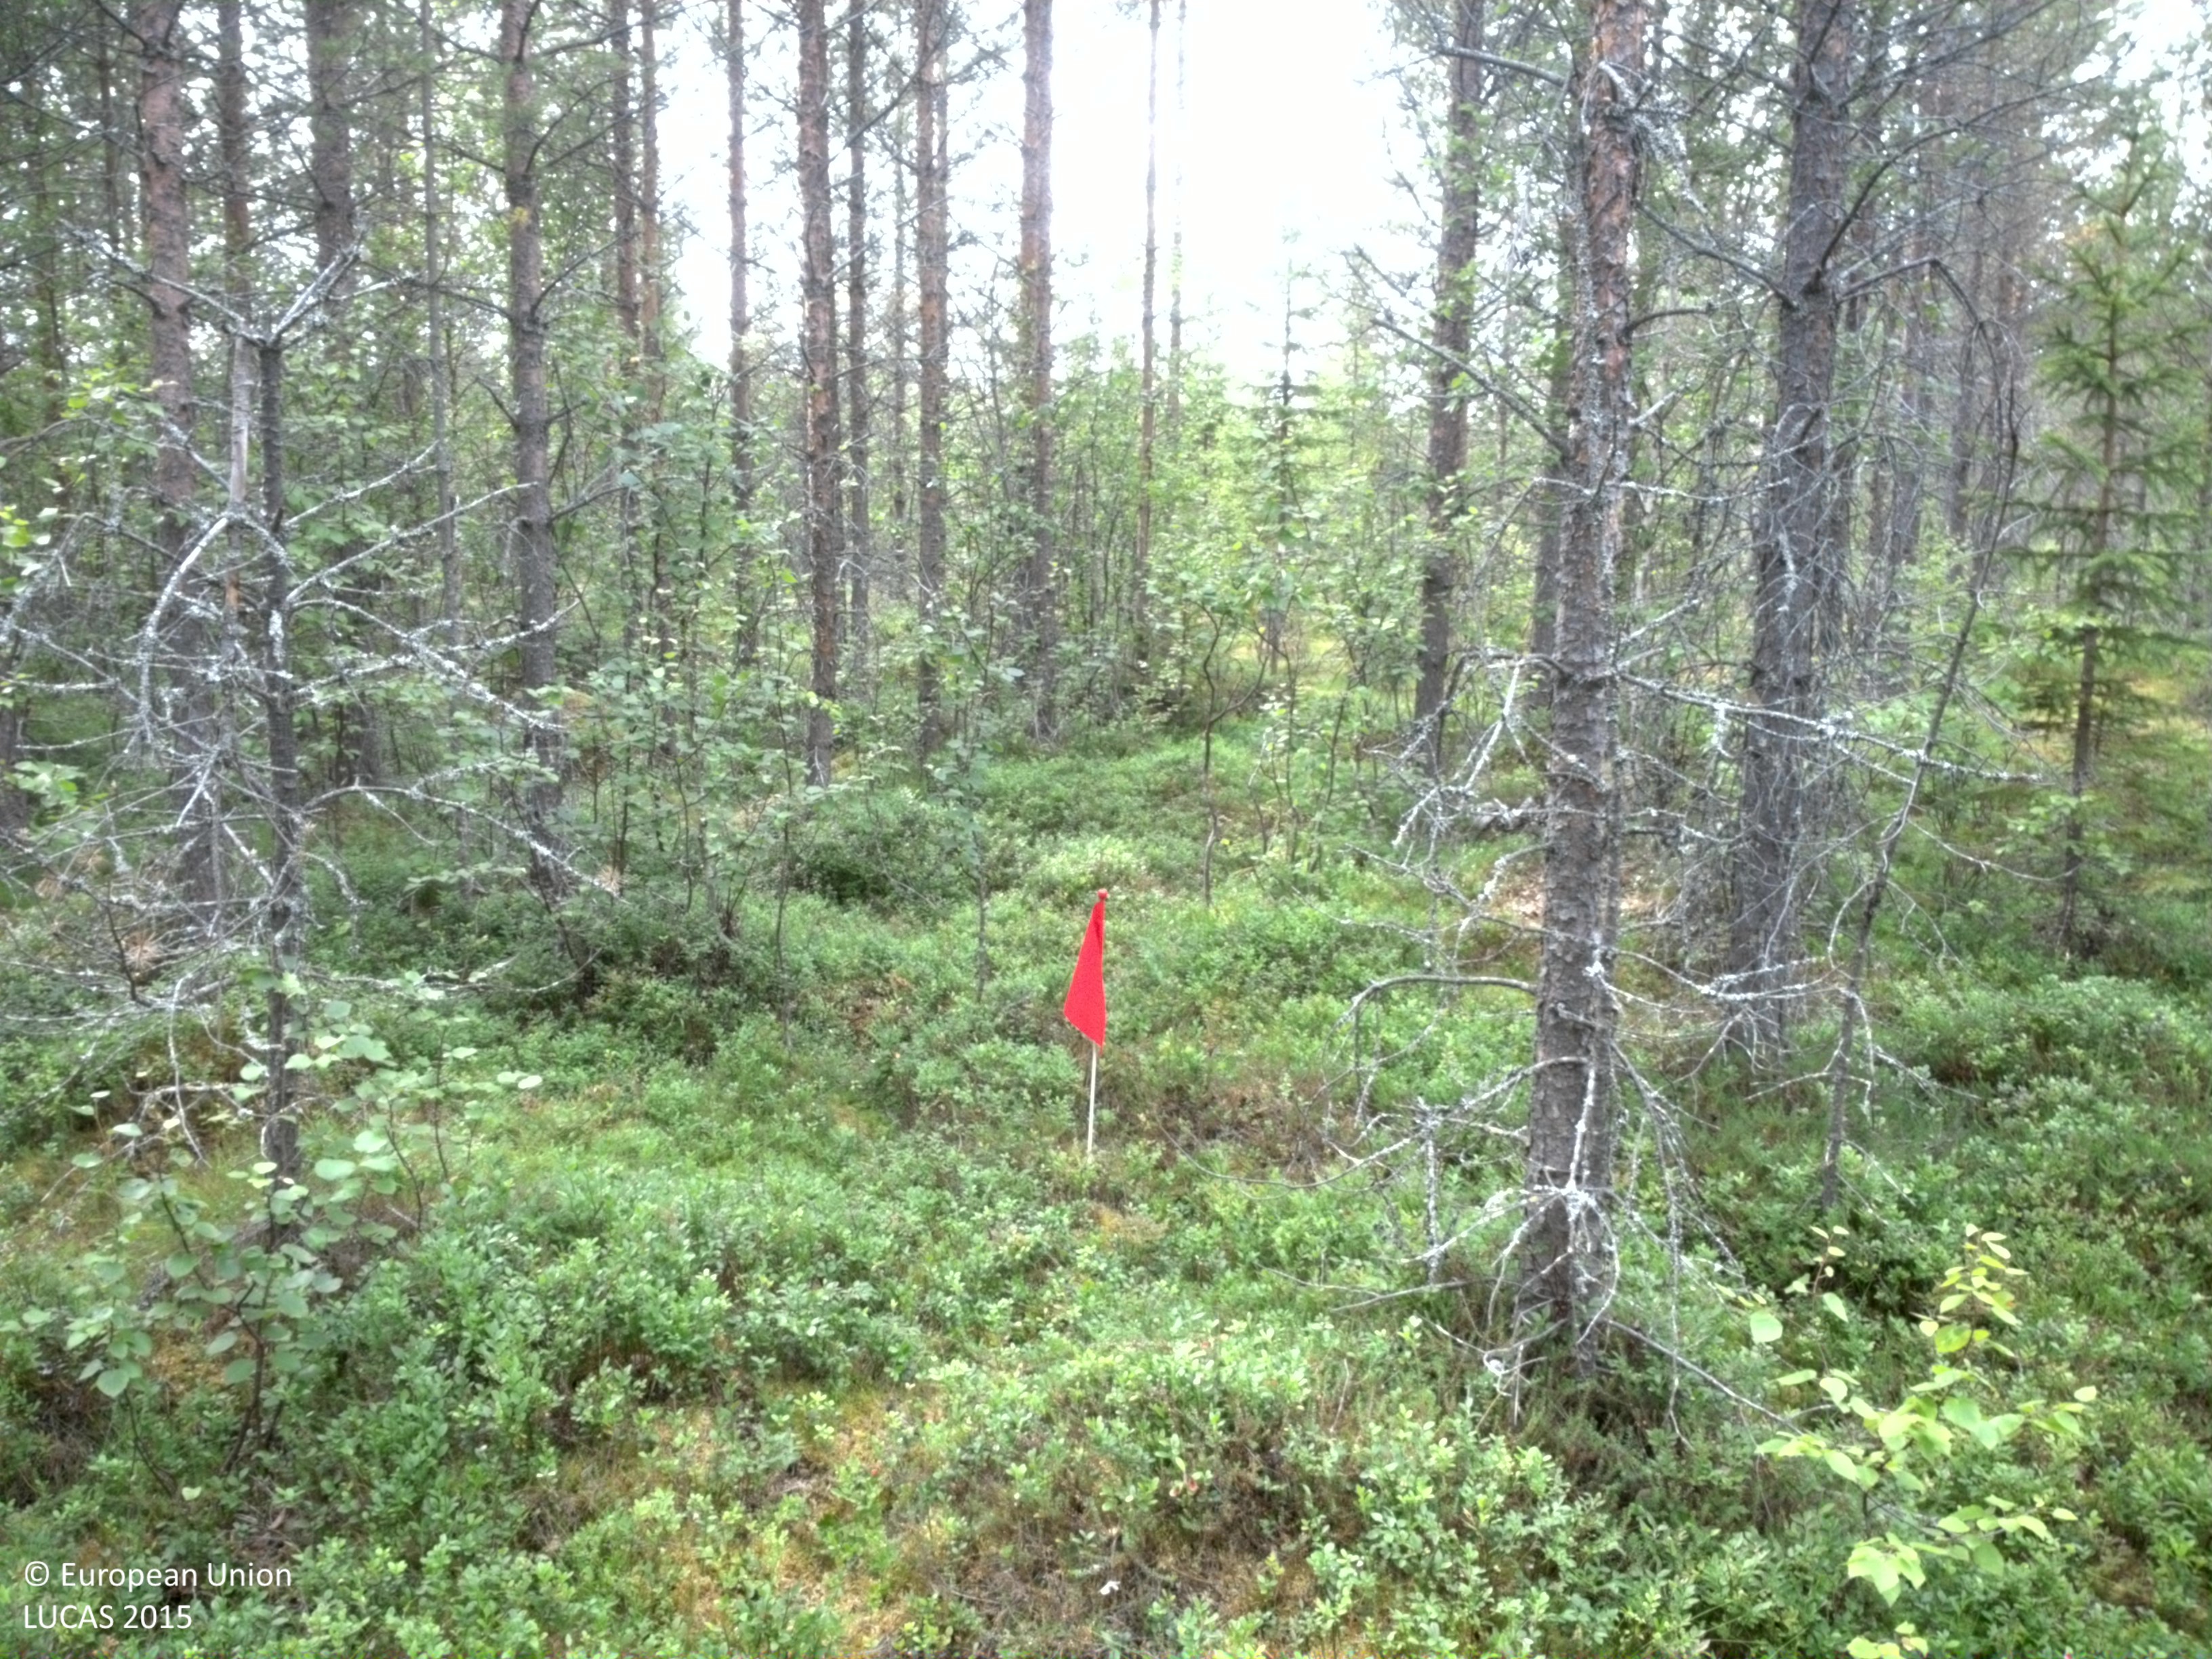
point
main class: Woodland
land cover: Pine dominated mixed woodland
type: boreal forest
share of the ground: 50 - 75 %
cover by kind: coniferous forest trees 45 %, shrubs 30 %, broadleaved forest trees 15 %, lichens and mosses 10 %
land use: Forestry
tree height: > 5 m
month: August
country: SE
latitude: 64.5371
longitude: 20.2946
